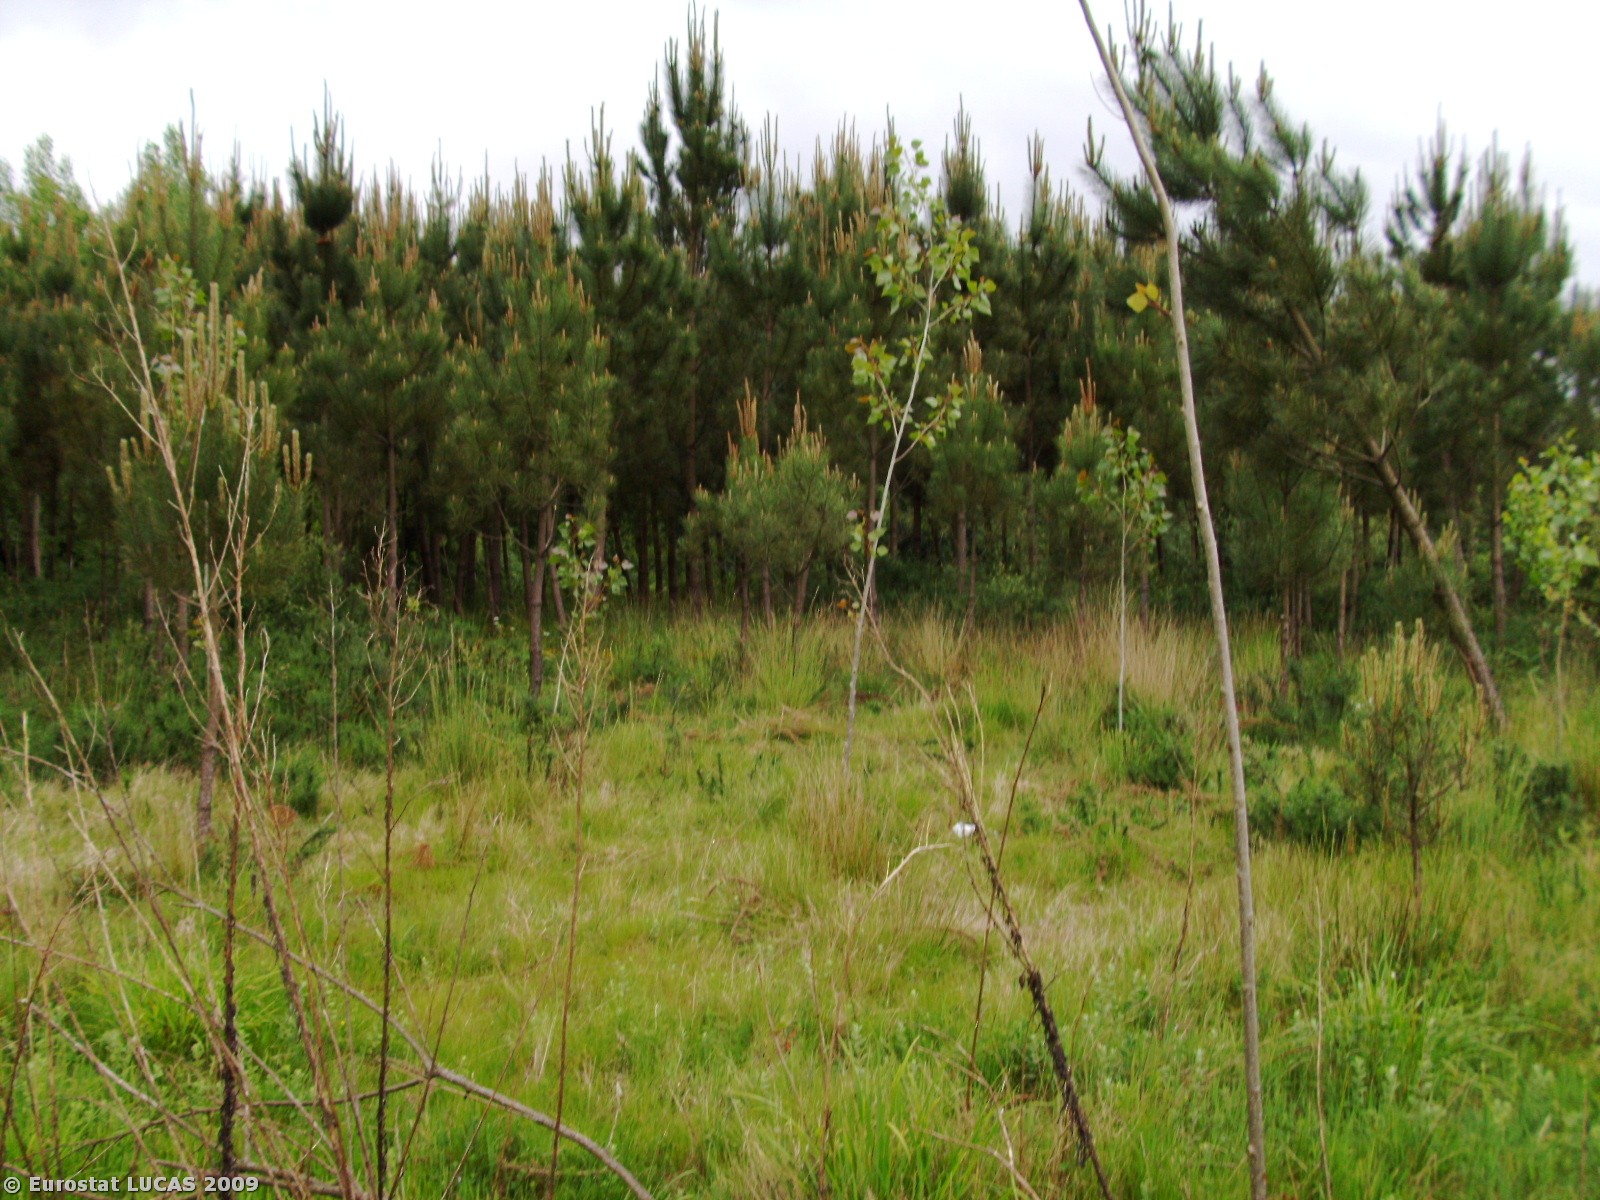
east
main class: Grassland
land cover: Spontaneously vegetated surfaces
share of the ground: > 75 %
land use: Fallow land
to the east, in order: Spontaneously vegetated surfaces; Coniferous woodland; Broadleaved woodland; Rivers and streams; Broadleaved woodland; Mixed cereals for fodder
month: May
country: PT
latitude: 40.9855
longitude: -8.5105
